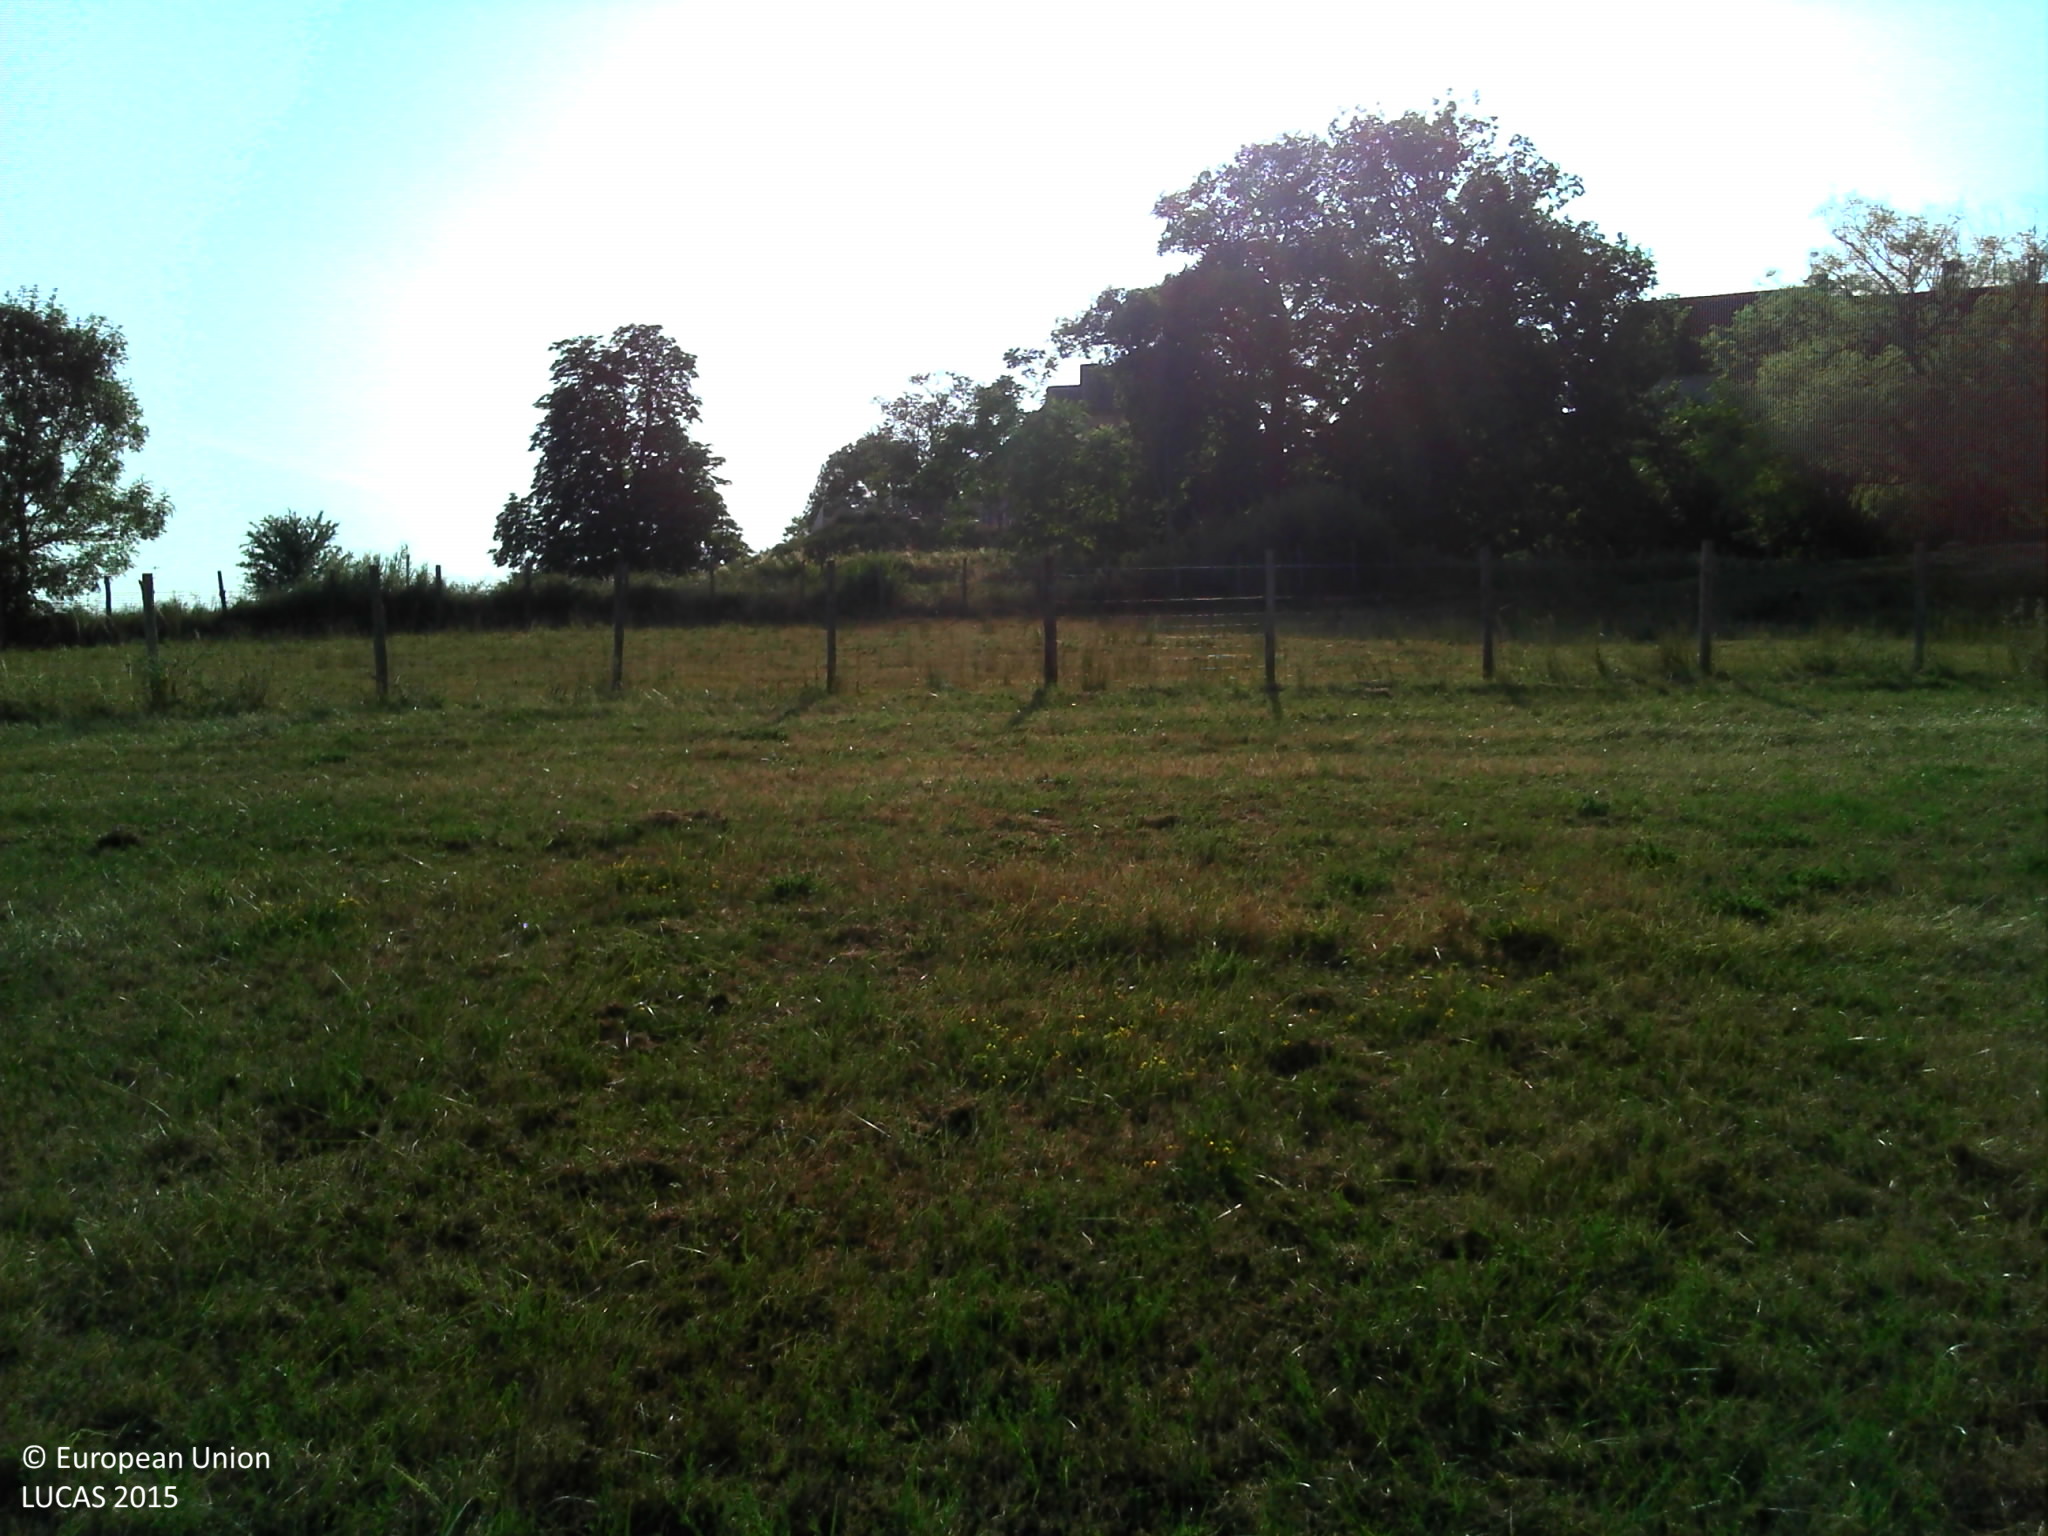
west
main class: Grassland
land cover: Grassland without tree/shrub cover
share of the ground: > 75 %
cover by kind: herbaceous plants 100 %
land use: Agriculture (excluding fallow land and kitchen gardens)
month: July
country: FR
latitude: 45.2893
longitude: 1.0797
